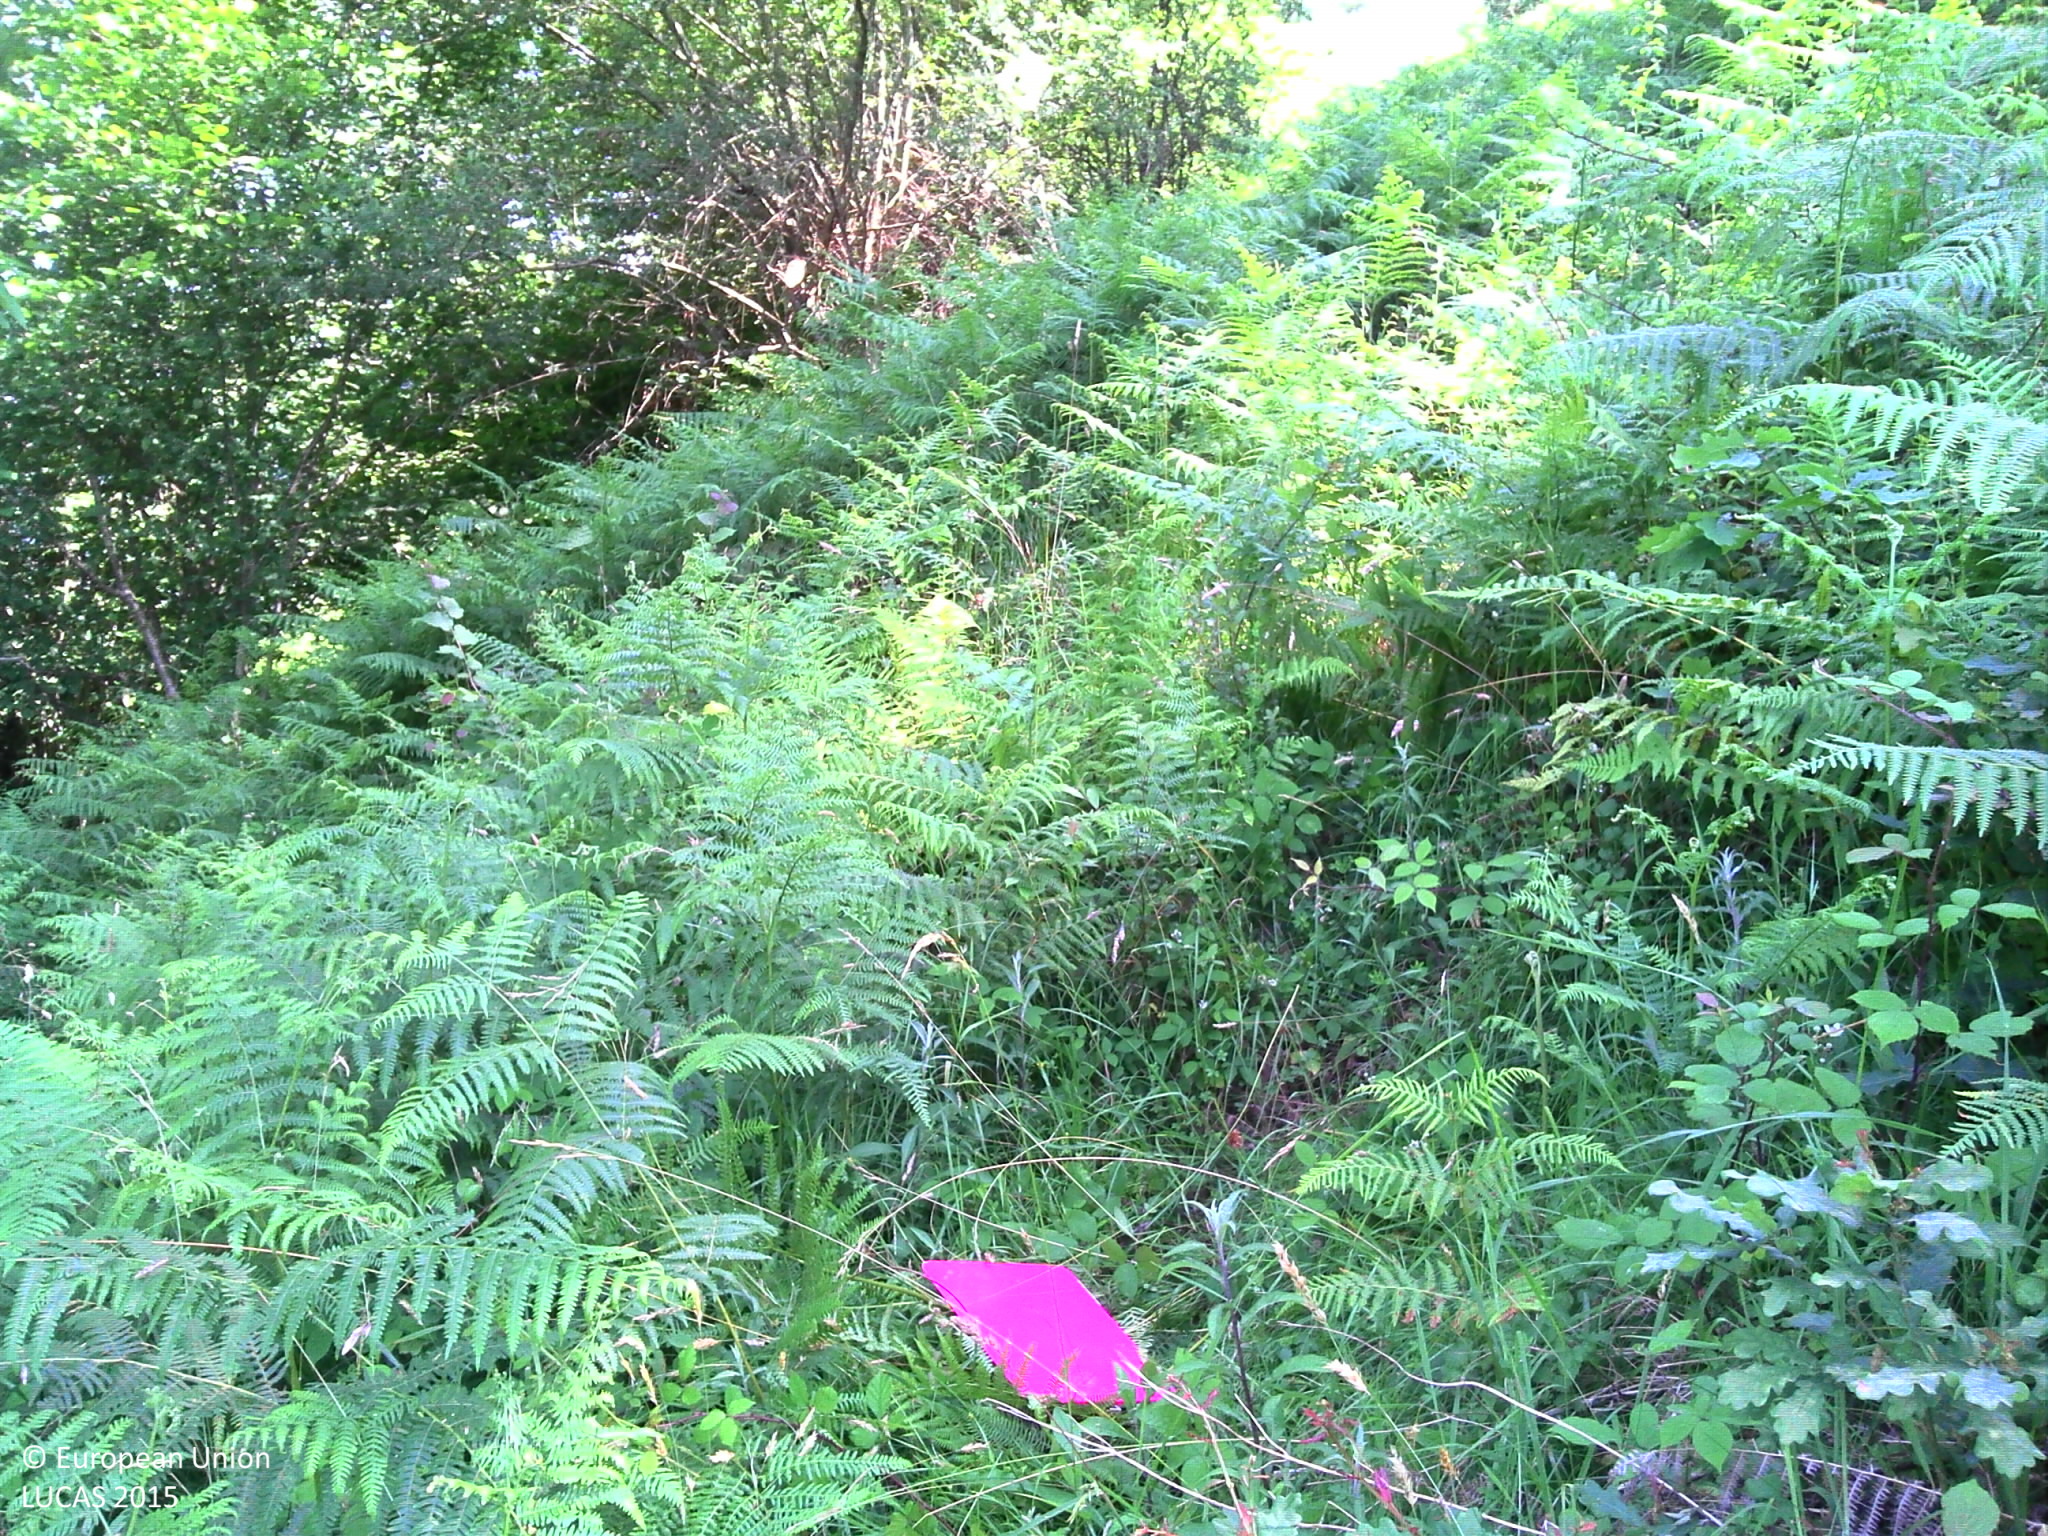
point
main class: Shrubland
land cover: Shrubland with sparse tree cover
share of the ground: > 75 %
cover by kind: herbaceous plants 85 %, shrubs 10 %, broadleaved forest trees 5 %
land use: Semi-natural and natural areas not in use
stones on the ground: < 10 %
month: June
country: FR
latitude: 43.1074
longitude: -0.1414
